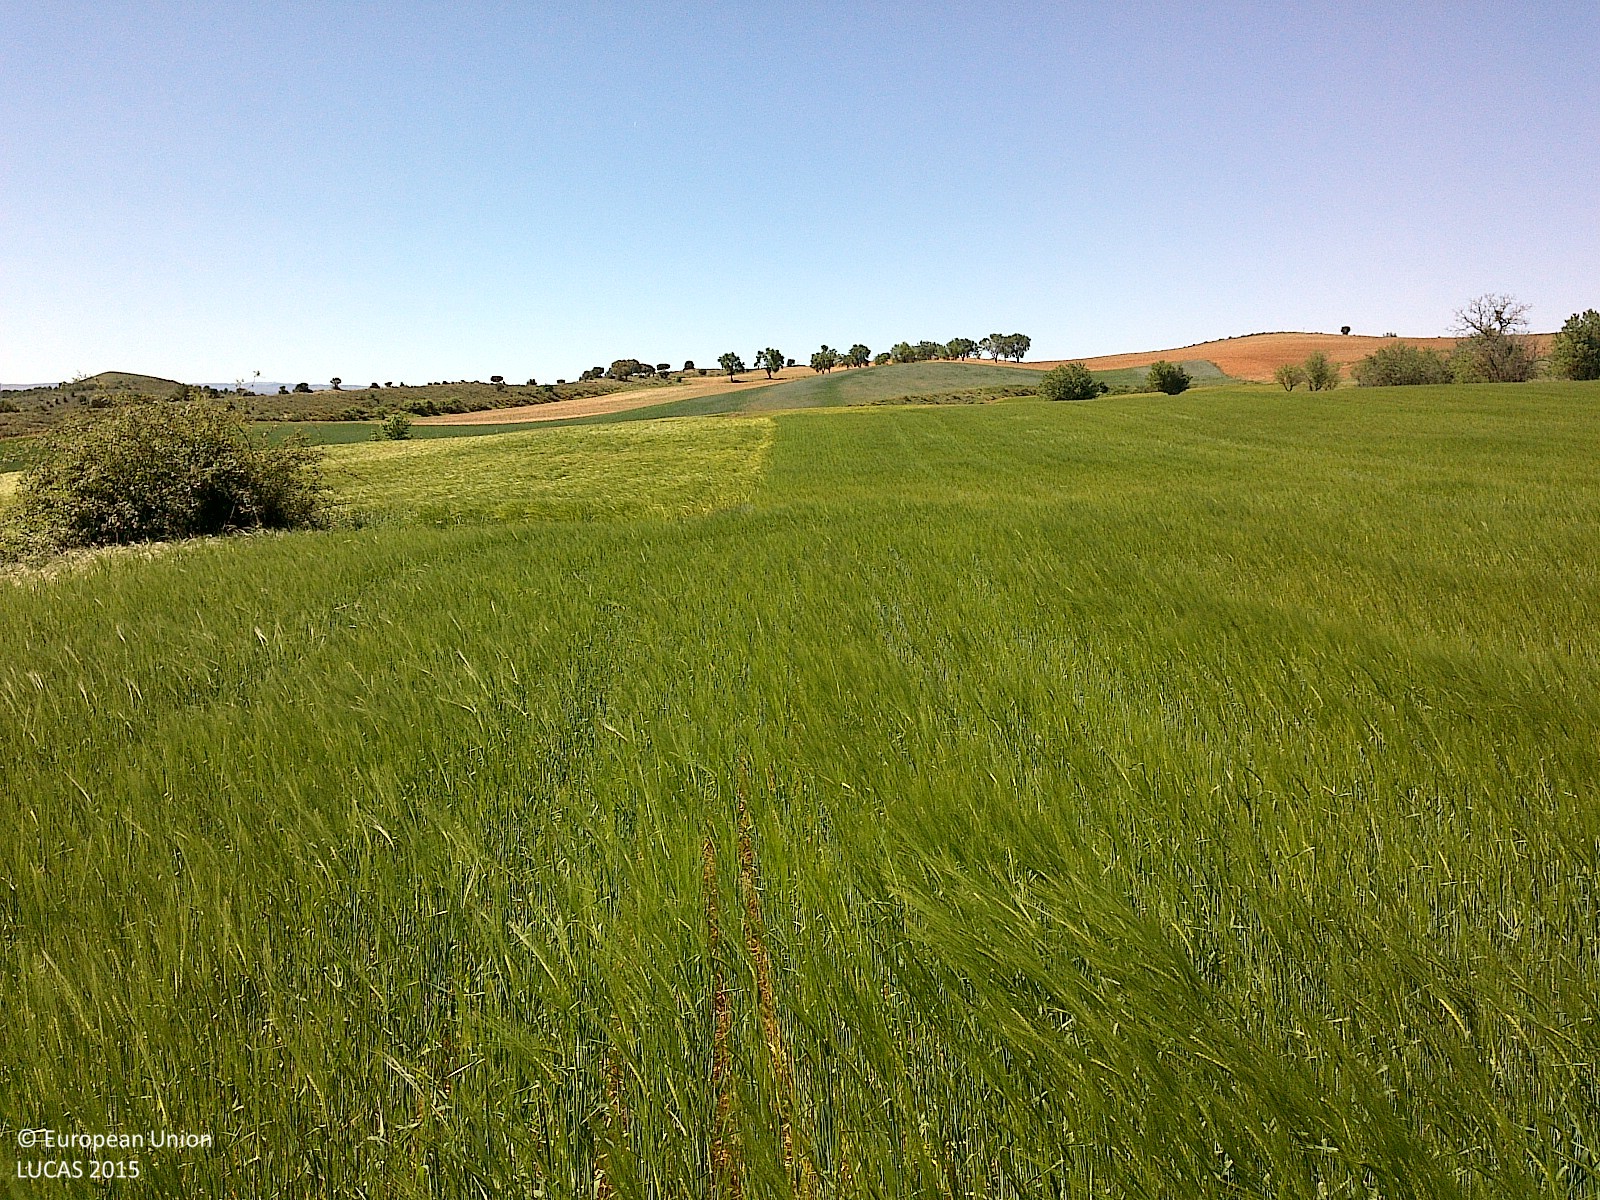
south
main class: Cropland
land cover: Barley
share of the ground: > 75 %
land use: Agriculture (excluding fallow land and kitchen gardens)
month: May
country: ES
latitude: 41.5614
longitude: -3.1015
